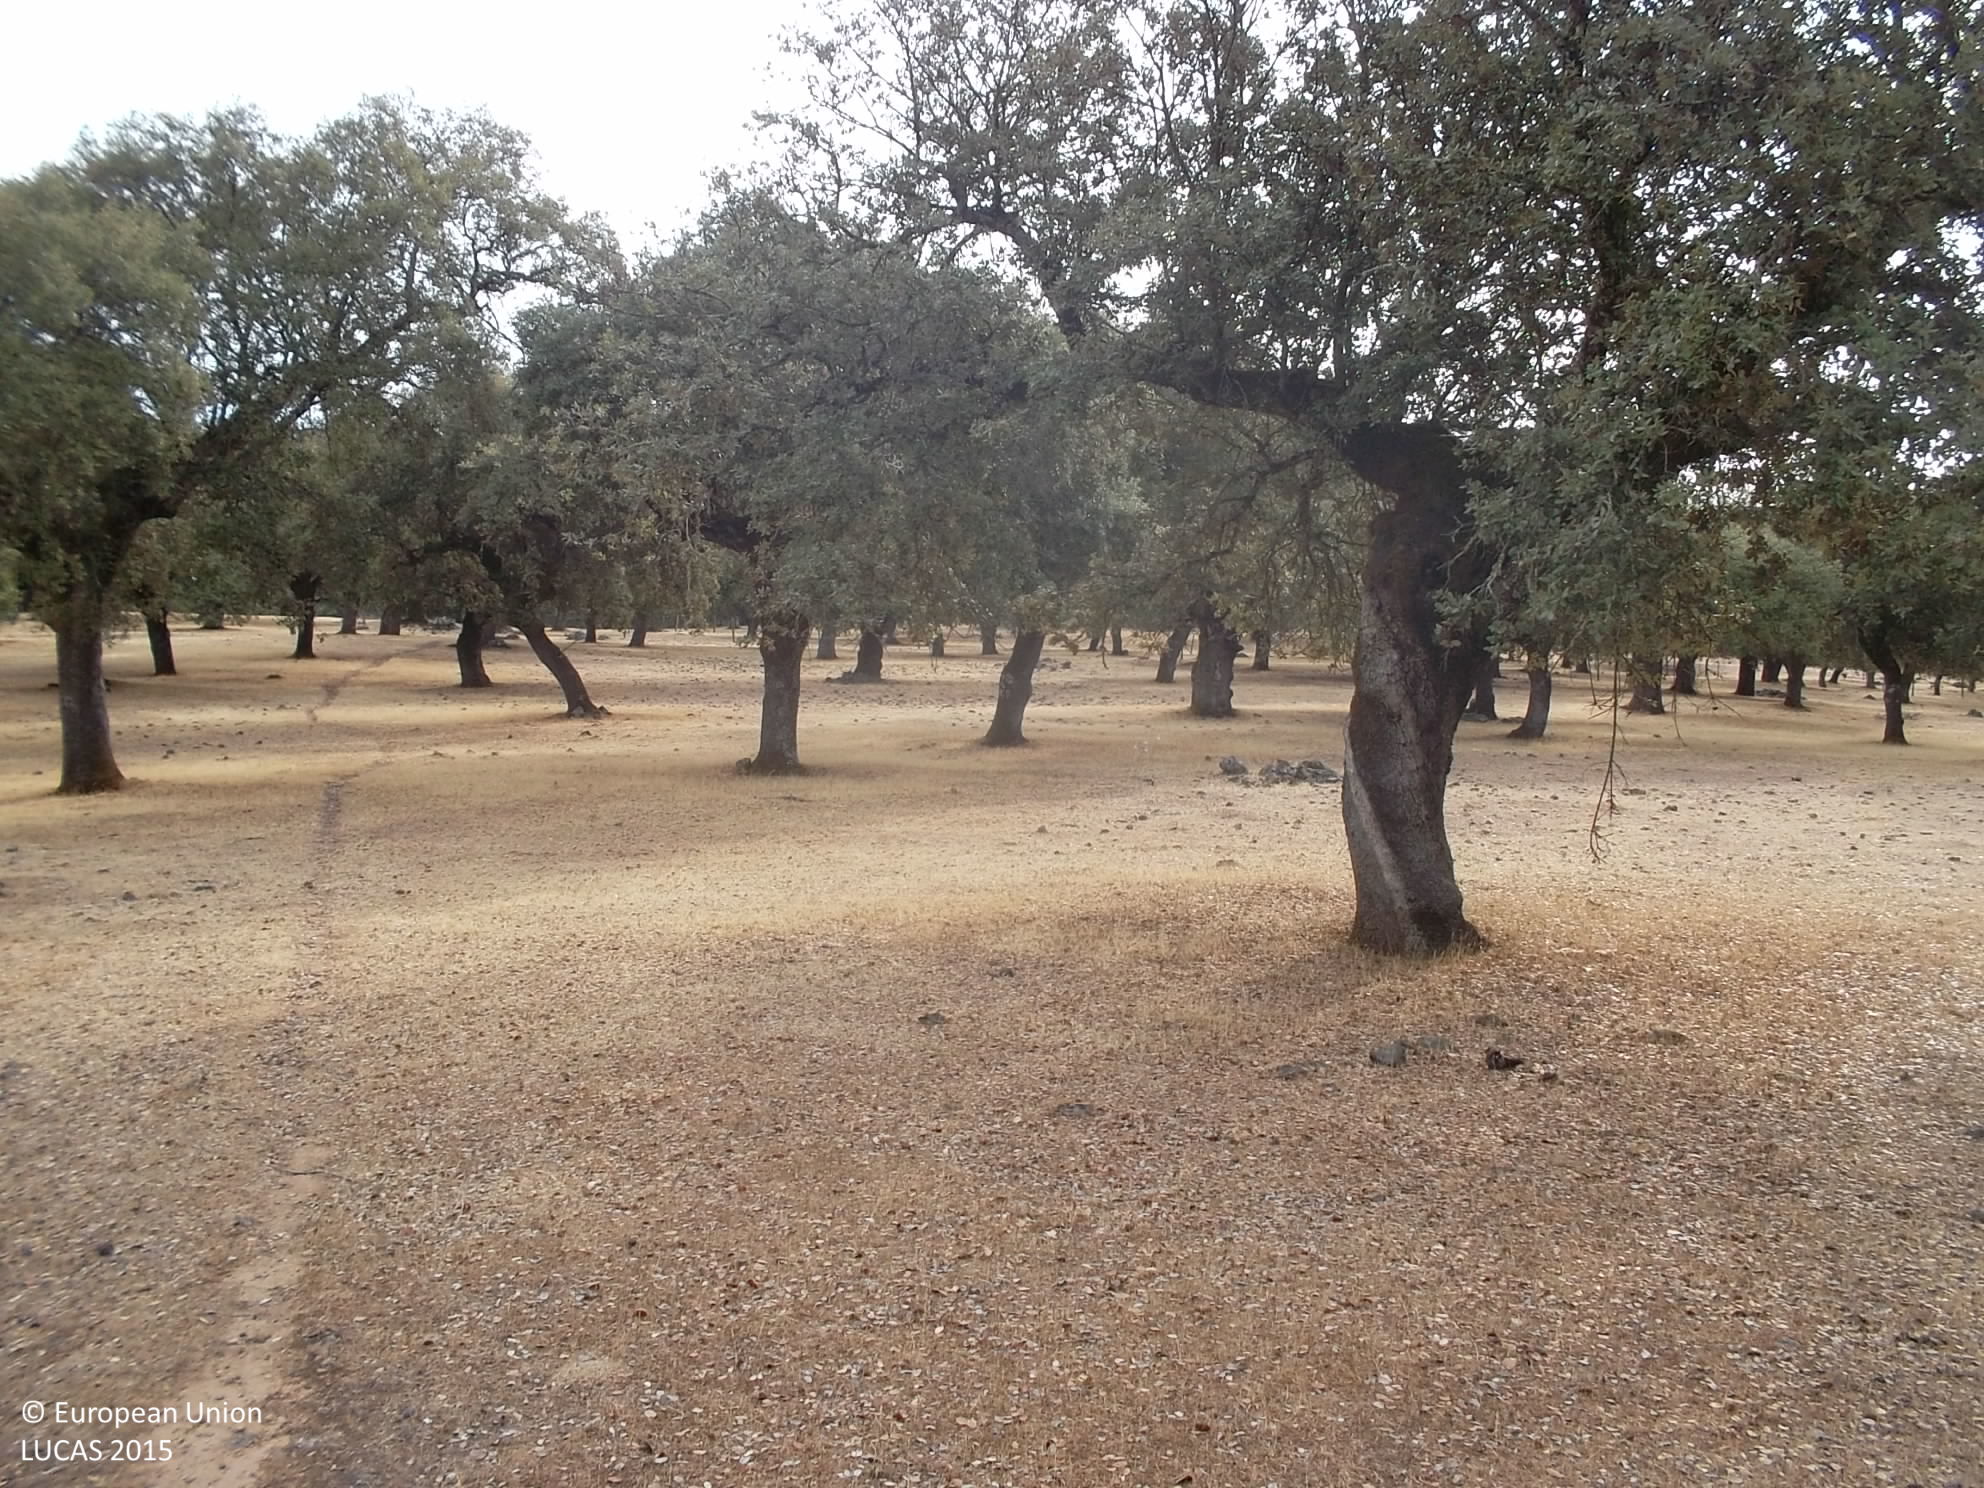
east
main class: Woodland
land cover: Broadleaved woodland
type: broadleaved evergreen forest
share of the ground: 25 - 50 %
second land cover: Grassland without tree/shrub cover
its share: 50 - 75 %
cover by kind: herbaceous plants 55 %, broadleaved forest trees 45 %
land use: Forestry
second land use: Agriculture (excluding fallow land and kitchen gardens)
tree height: > 5 m
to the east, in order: Broadleaved woodland; Grassland without tree/shrub cover
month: September
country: ES
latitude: 38.4780
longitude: -6.7829
